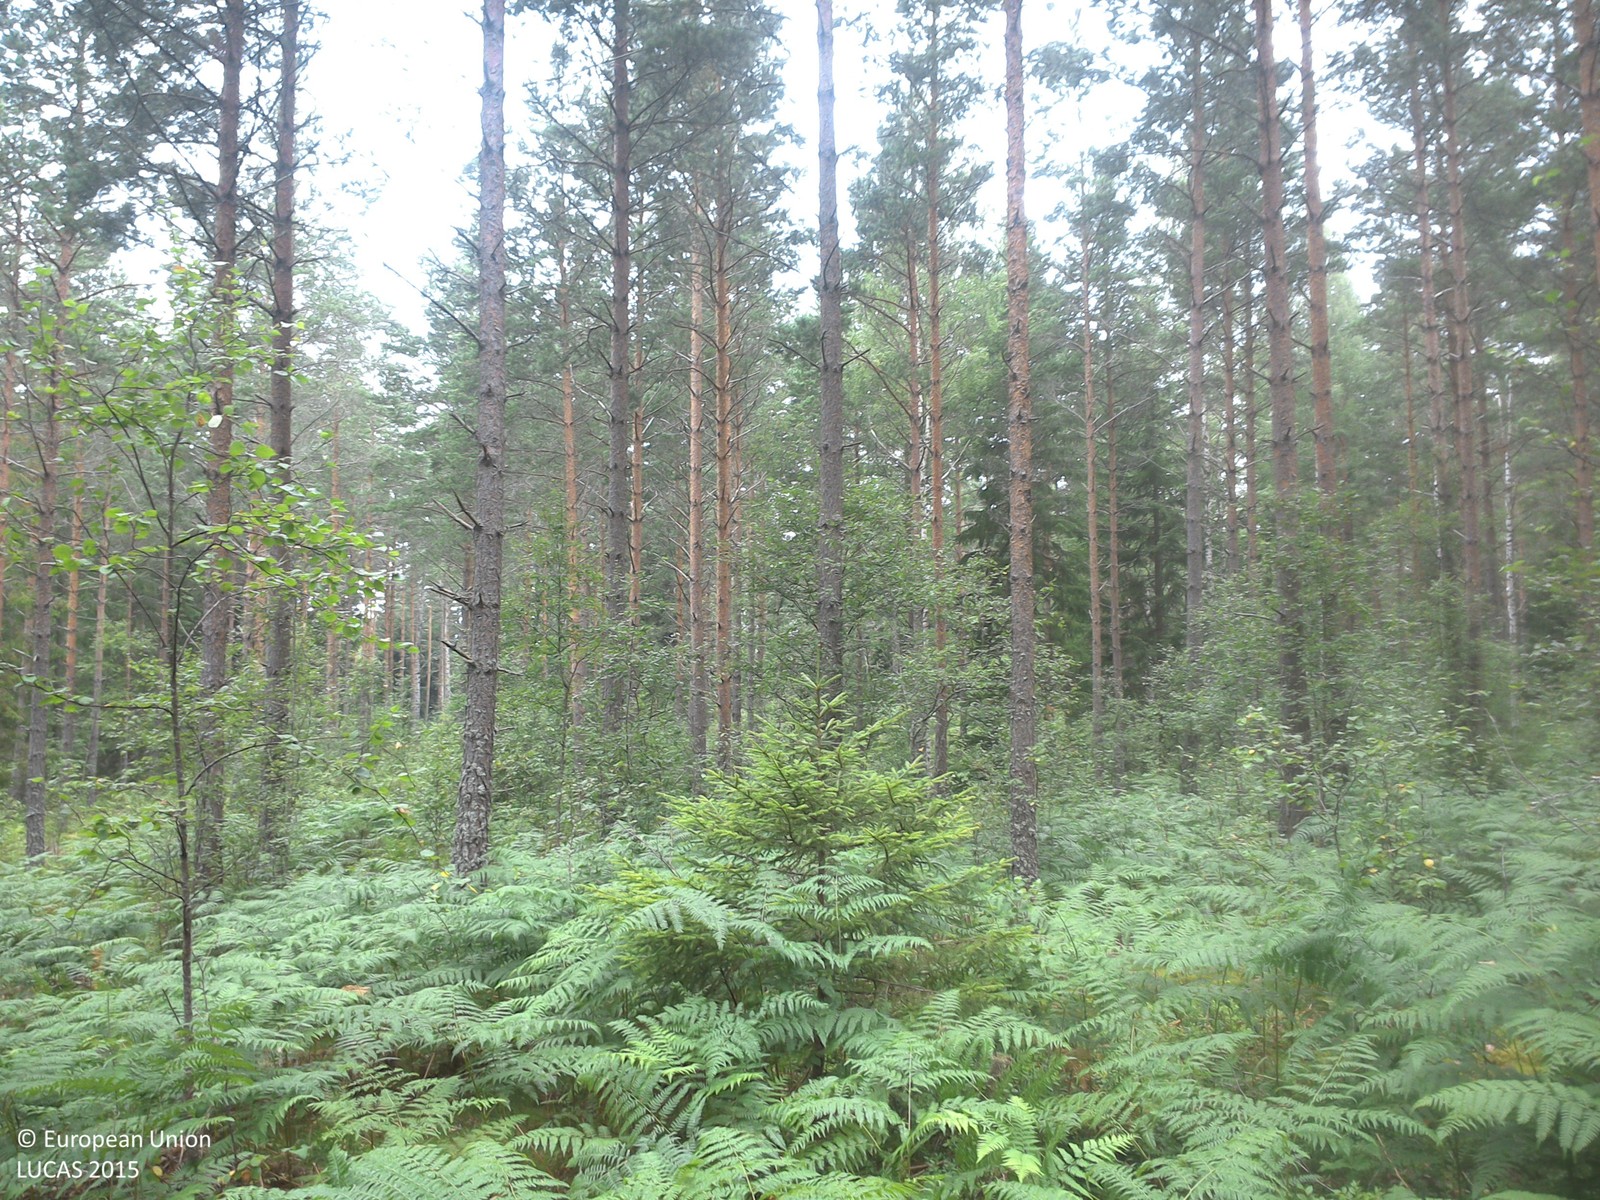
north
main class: Woodland
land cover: Pine dominated coniferous woodland
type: boreal forest
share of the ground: 25 - 50 %
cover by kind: herbaceous plants 50 %, coniferous forest trees 35 %, lichens and mosses 15 %
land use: Forestry
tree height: > 5 m
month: August
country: SE
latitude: 57.8253
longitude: 15.3332
